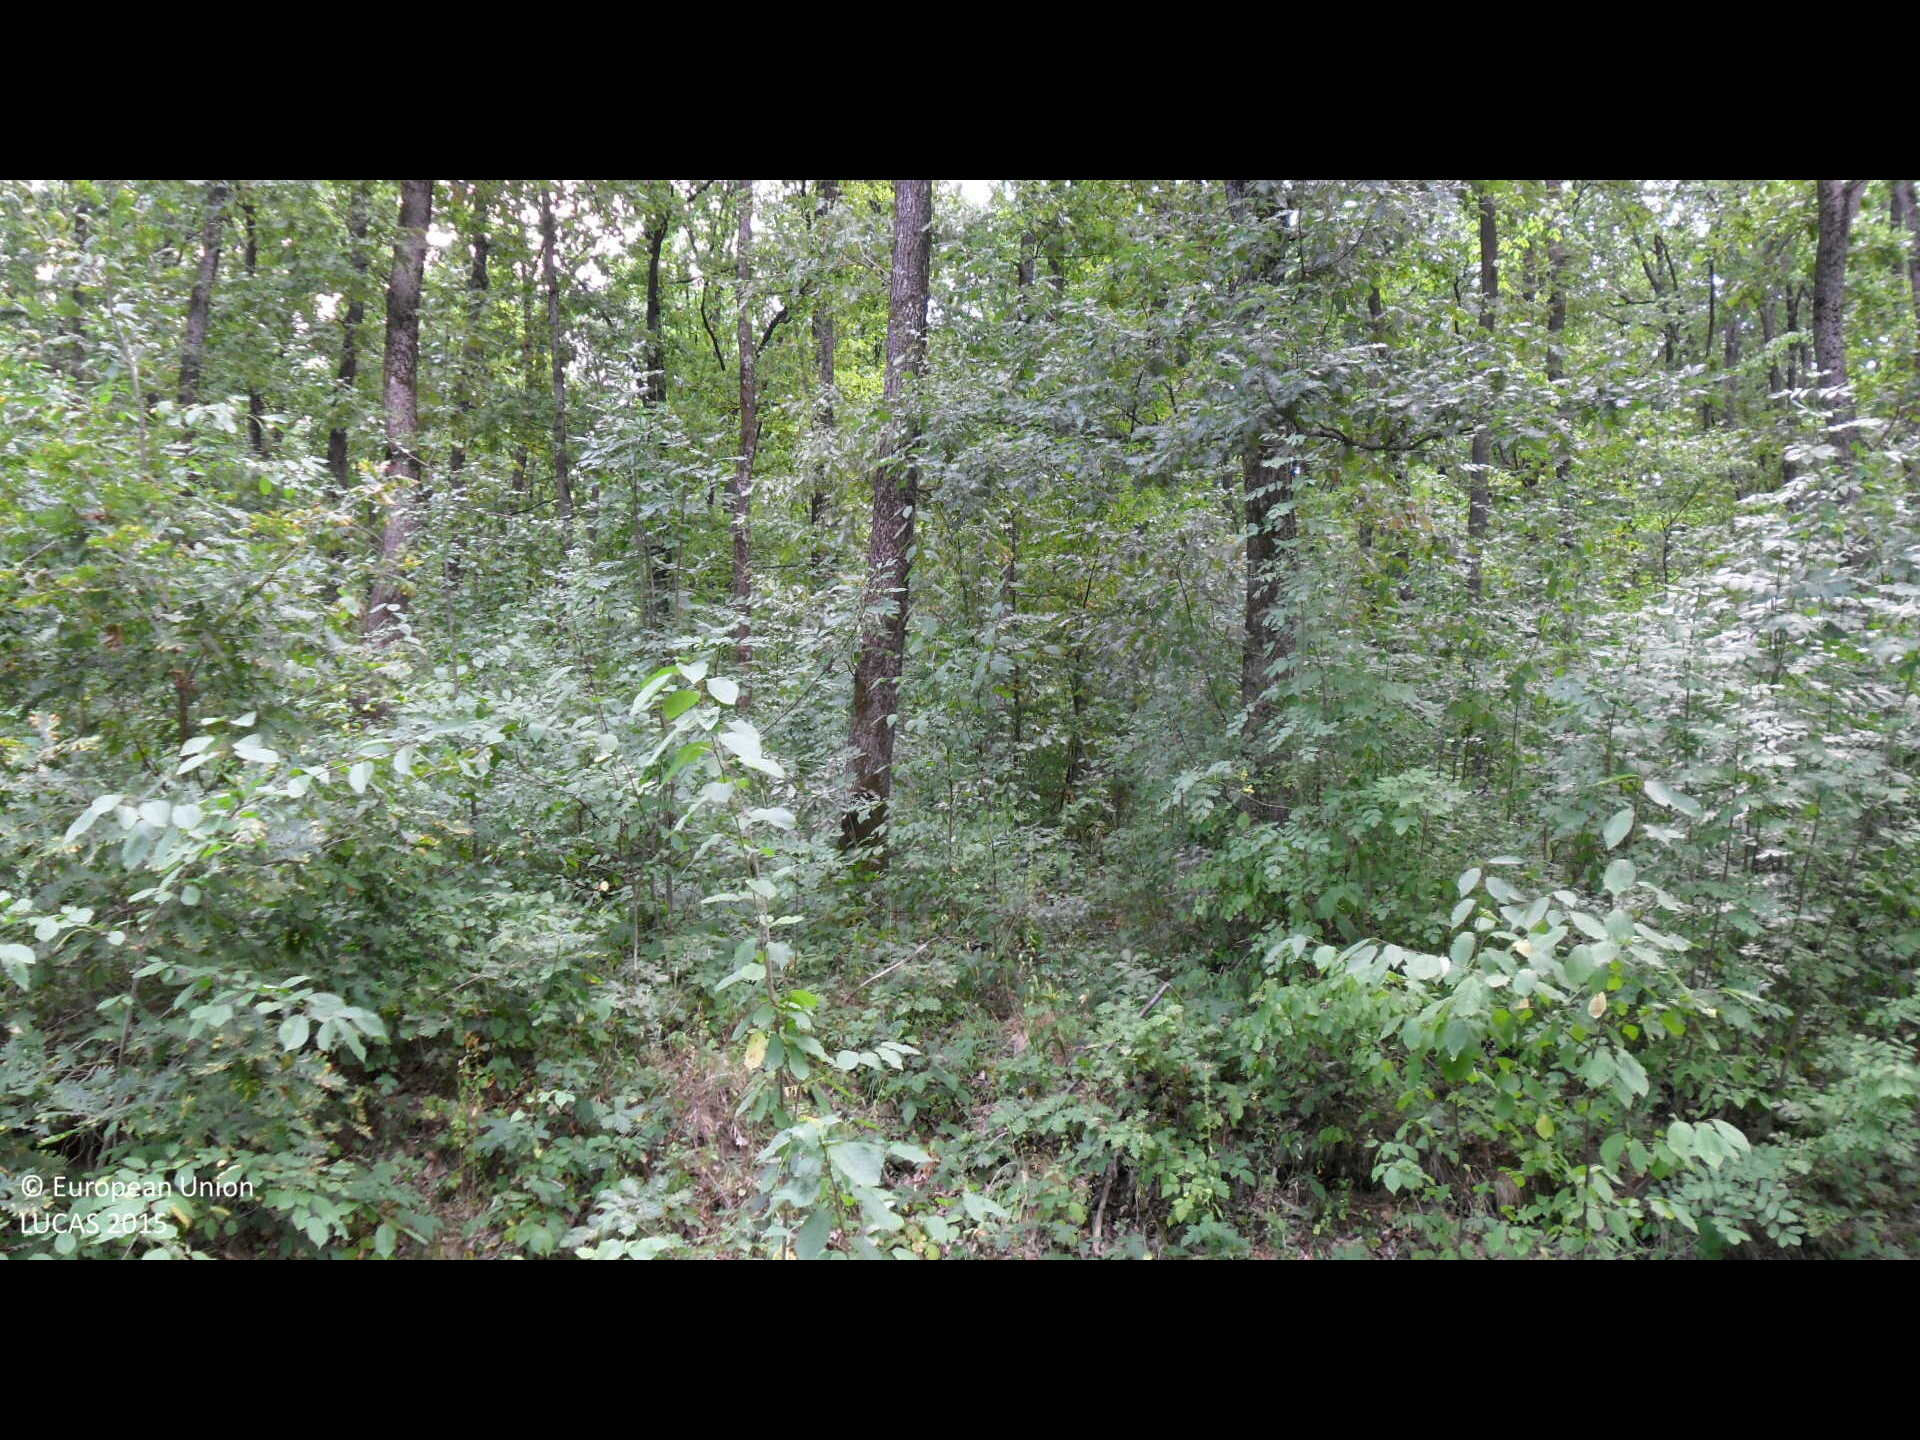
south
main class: Woodland
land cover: Broadleaved woodland
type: mesophytic deciduous forest
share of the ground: > 75 %
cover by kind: broadleaved forest trees 95 %, shrubs 5 %
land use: Forestry
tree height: > 5 m
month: August
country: BG
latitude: 43.2776
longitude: 26.3768
